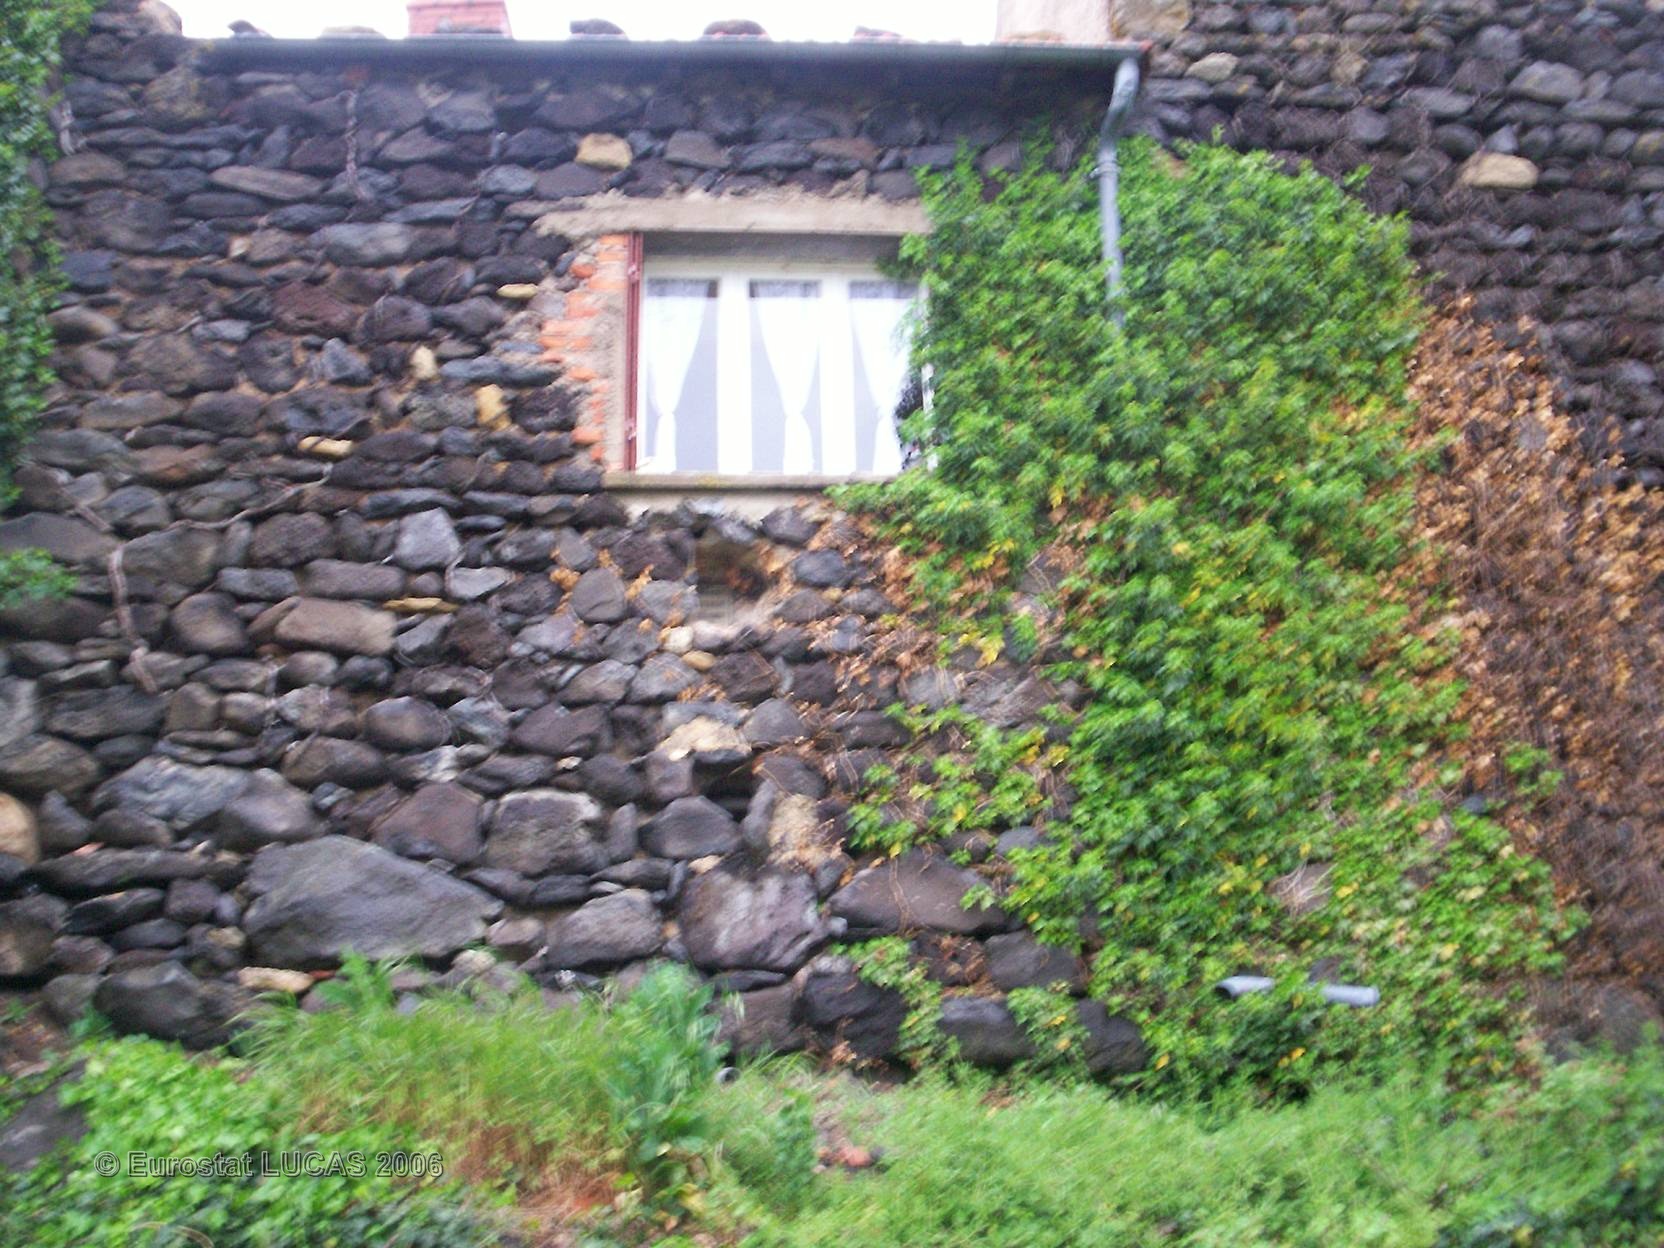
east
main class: Grassland
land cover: Grassland without tree/shrub cover
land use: Unused
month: May
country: FR
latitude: 45.4665
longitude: 3.2096
